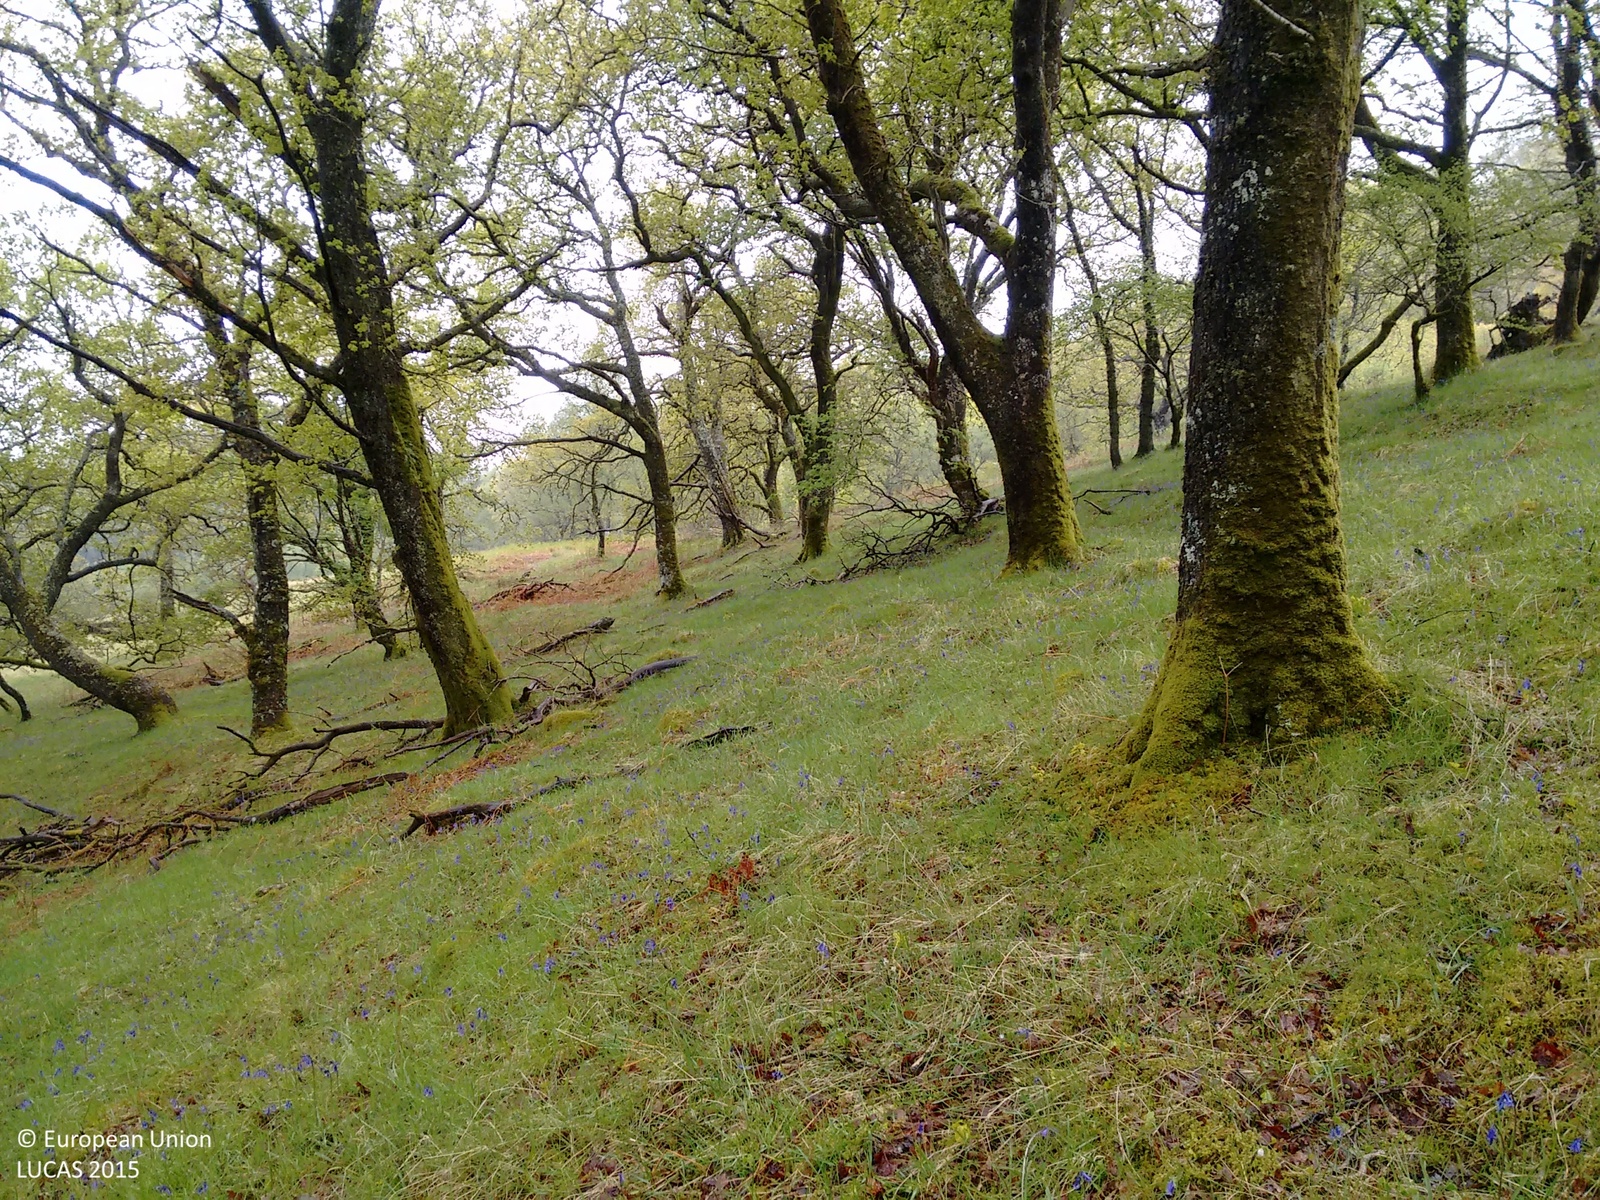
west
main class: Woodland
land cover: Broadleaved woodland
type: acidophilous oak and oak-birch forest
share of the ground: > 75 %
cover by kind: broadleaved forest trees 100 %
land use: Semi-natural and natural areas not in use
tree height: > 5 m
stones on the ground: 10 - 25 %
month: June
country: GB
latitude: 56.1548
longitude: -5.1990
